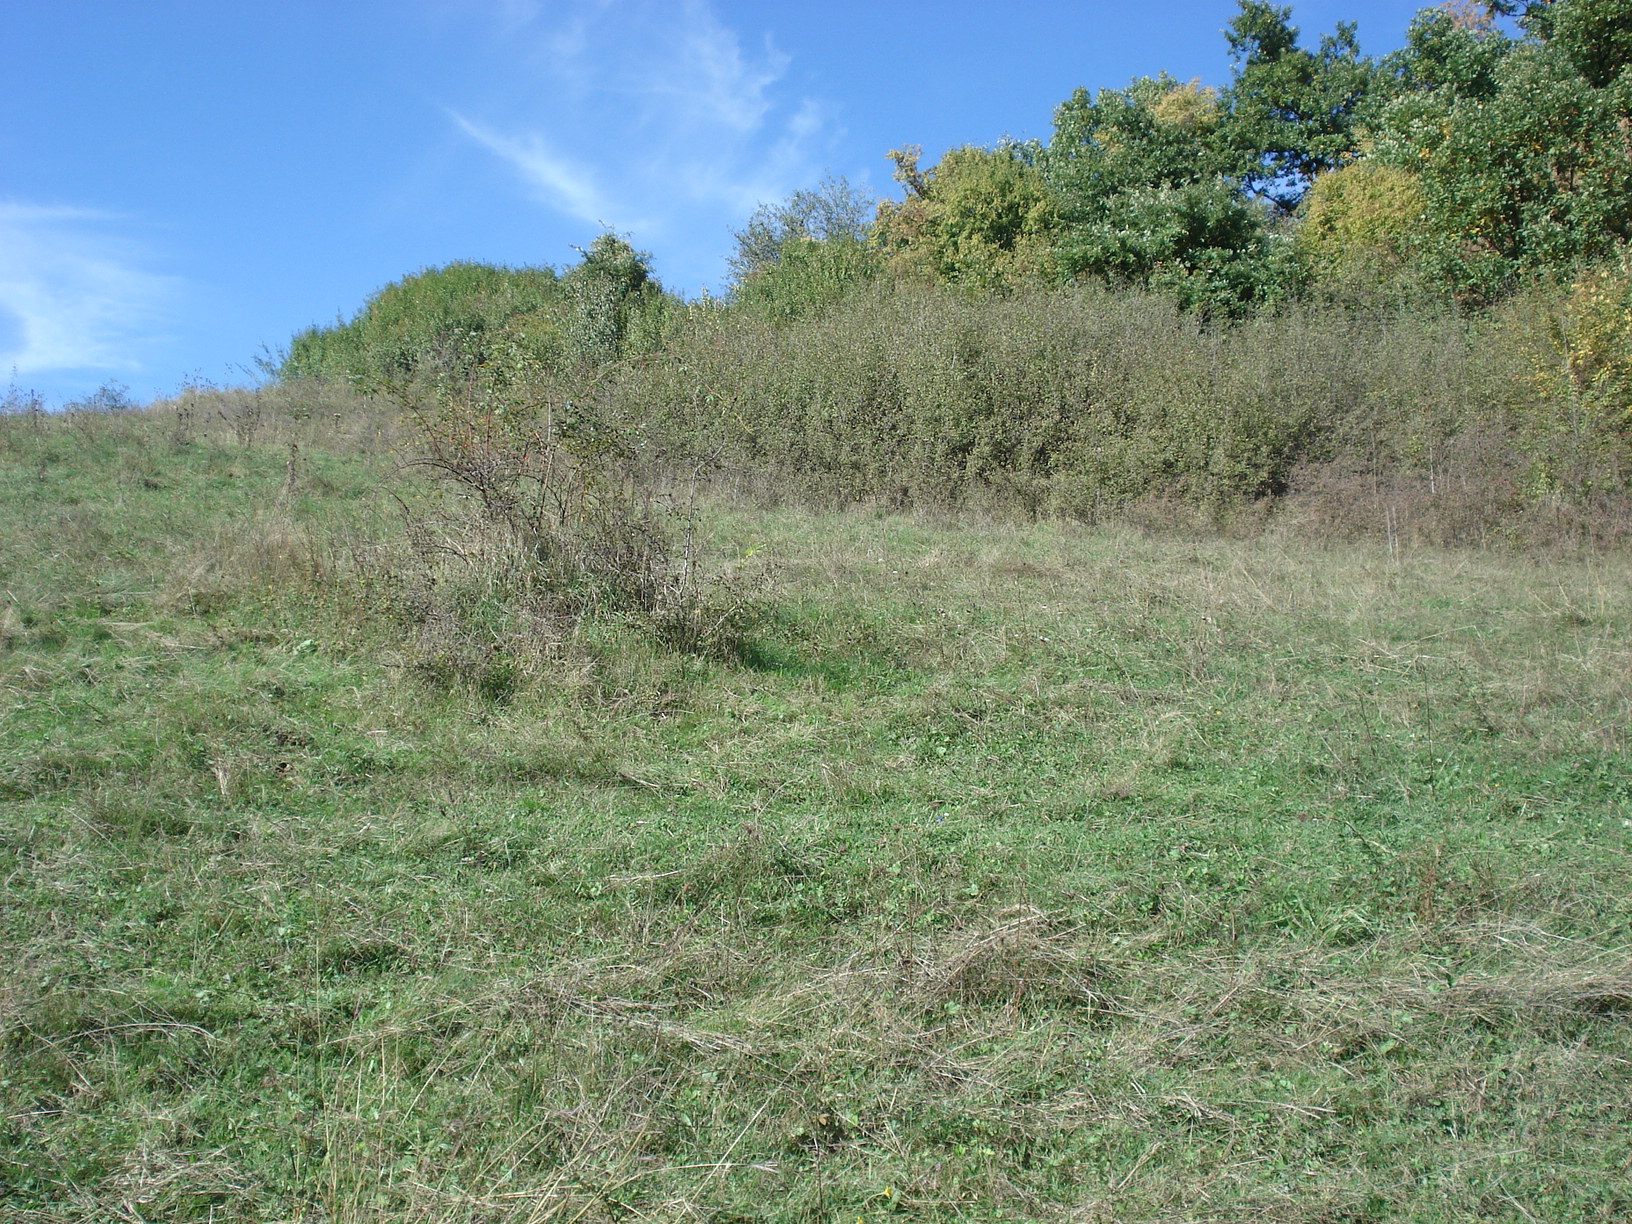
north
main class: Grassland
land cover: Grassland without tree/shrub cover
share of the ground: > 75 %
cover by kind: herbaceous plants 100 %
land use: Agriculture (excluding fallow land and kitchen gardens)
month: October
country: BG
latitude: 42.9572
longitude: 26.0853
